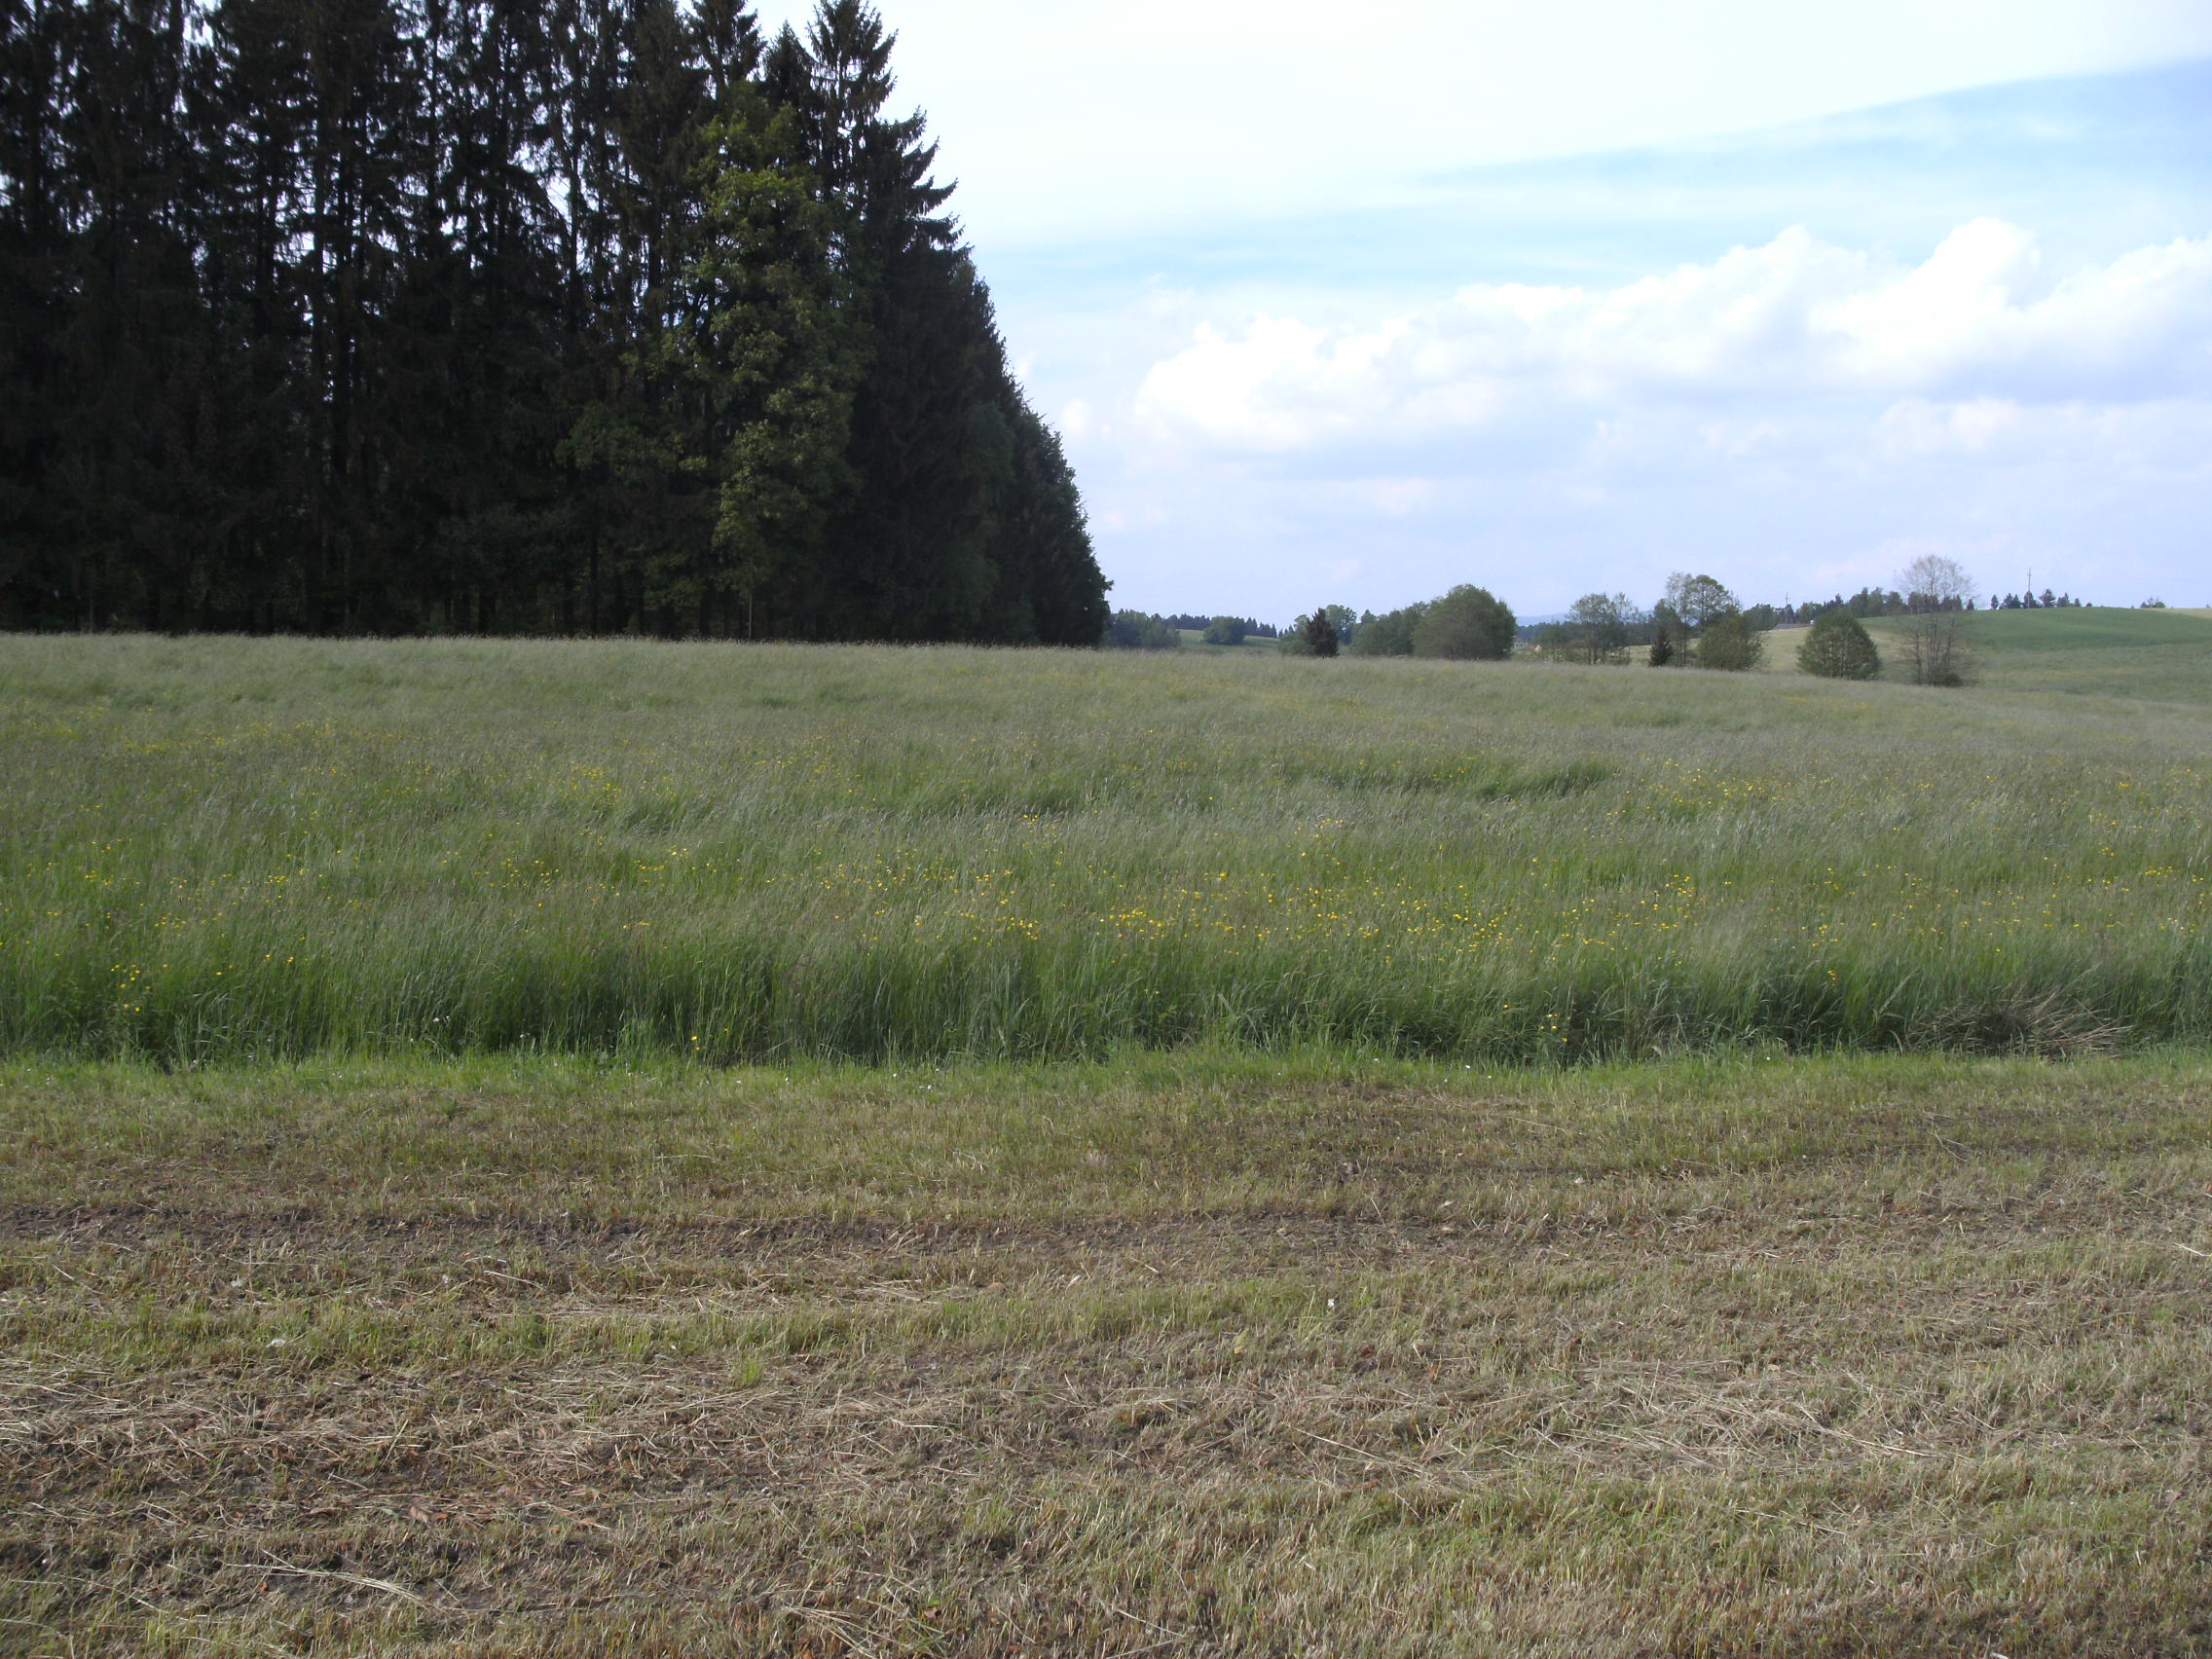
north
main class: Grassland
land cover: Grassland without tree/shrub cover
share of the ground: > 75 %
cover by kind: herbaceous plants 100 %
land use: Agriculture (excluding fallow land and kitchen gardens)
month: May
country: AT
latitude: 48.4113
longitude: 13.7690
